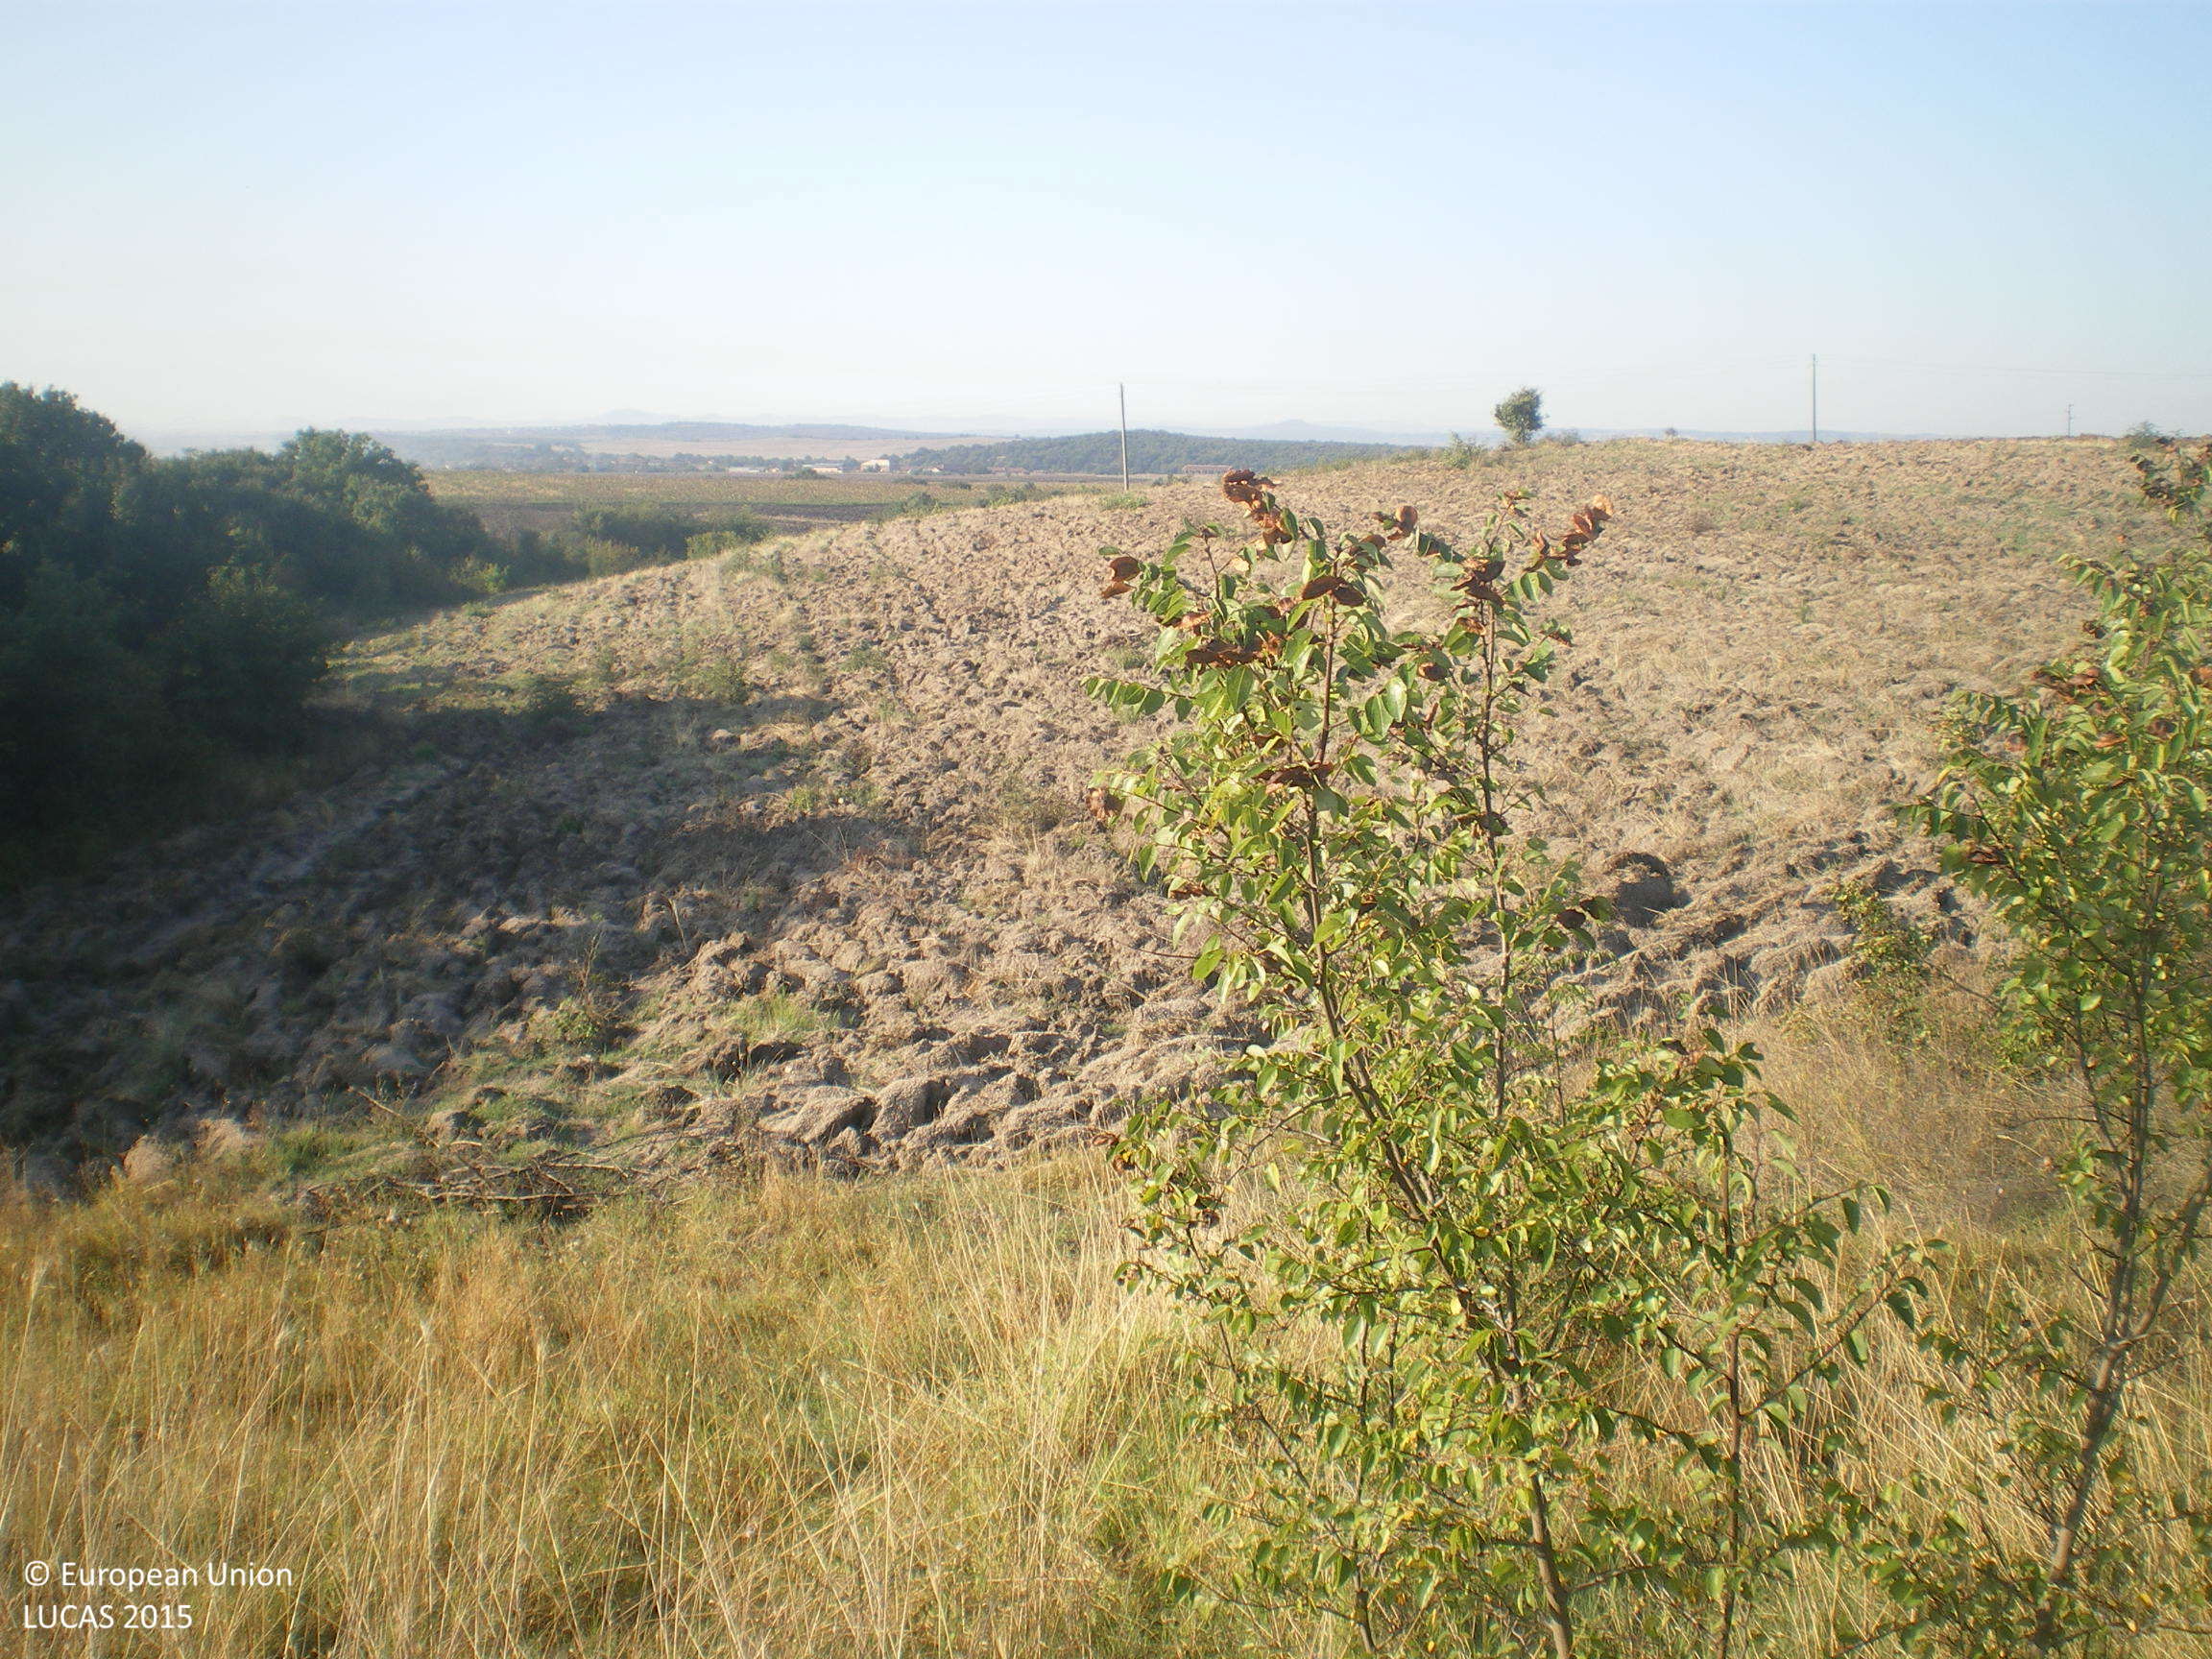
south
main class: Grassland
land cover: Grassland with sparse tree/shrub cover
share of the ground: > 75 %
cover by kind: herbaceous plants 90 %, broadleaved forest trees 5 %, shrubs 5 %
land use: Agriculture (excluding fallow land and kitchen gardens)
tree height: > 5 m
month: August
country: BG
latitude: 42.0480
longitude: 25.9125
